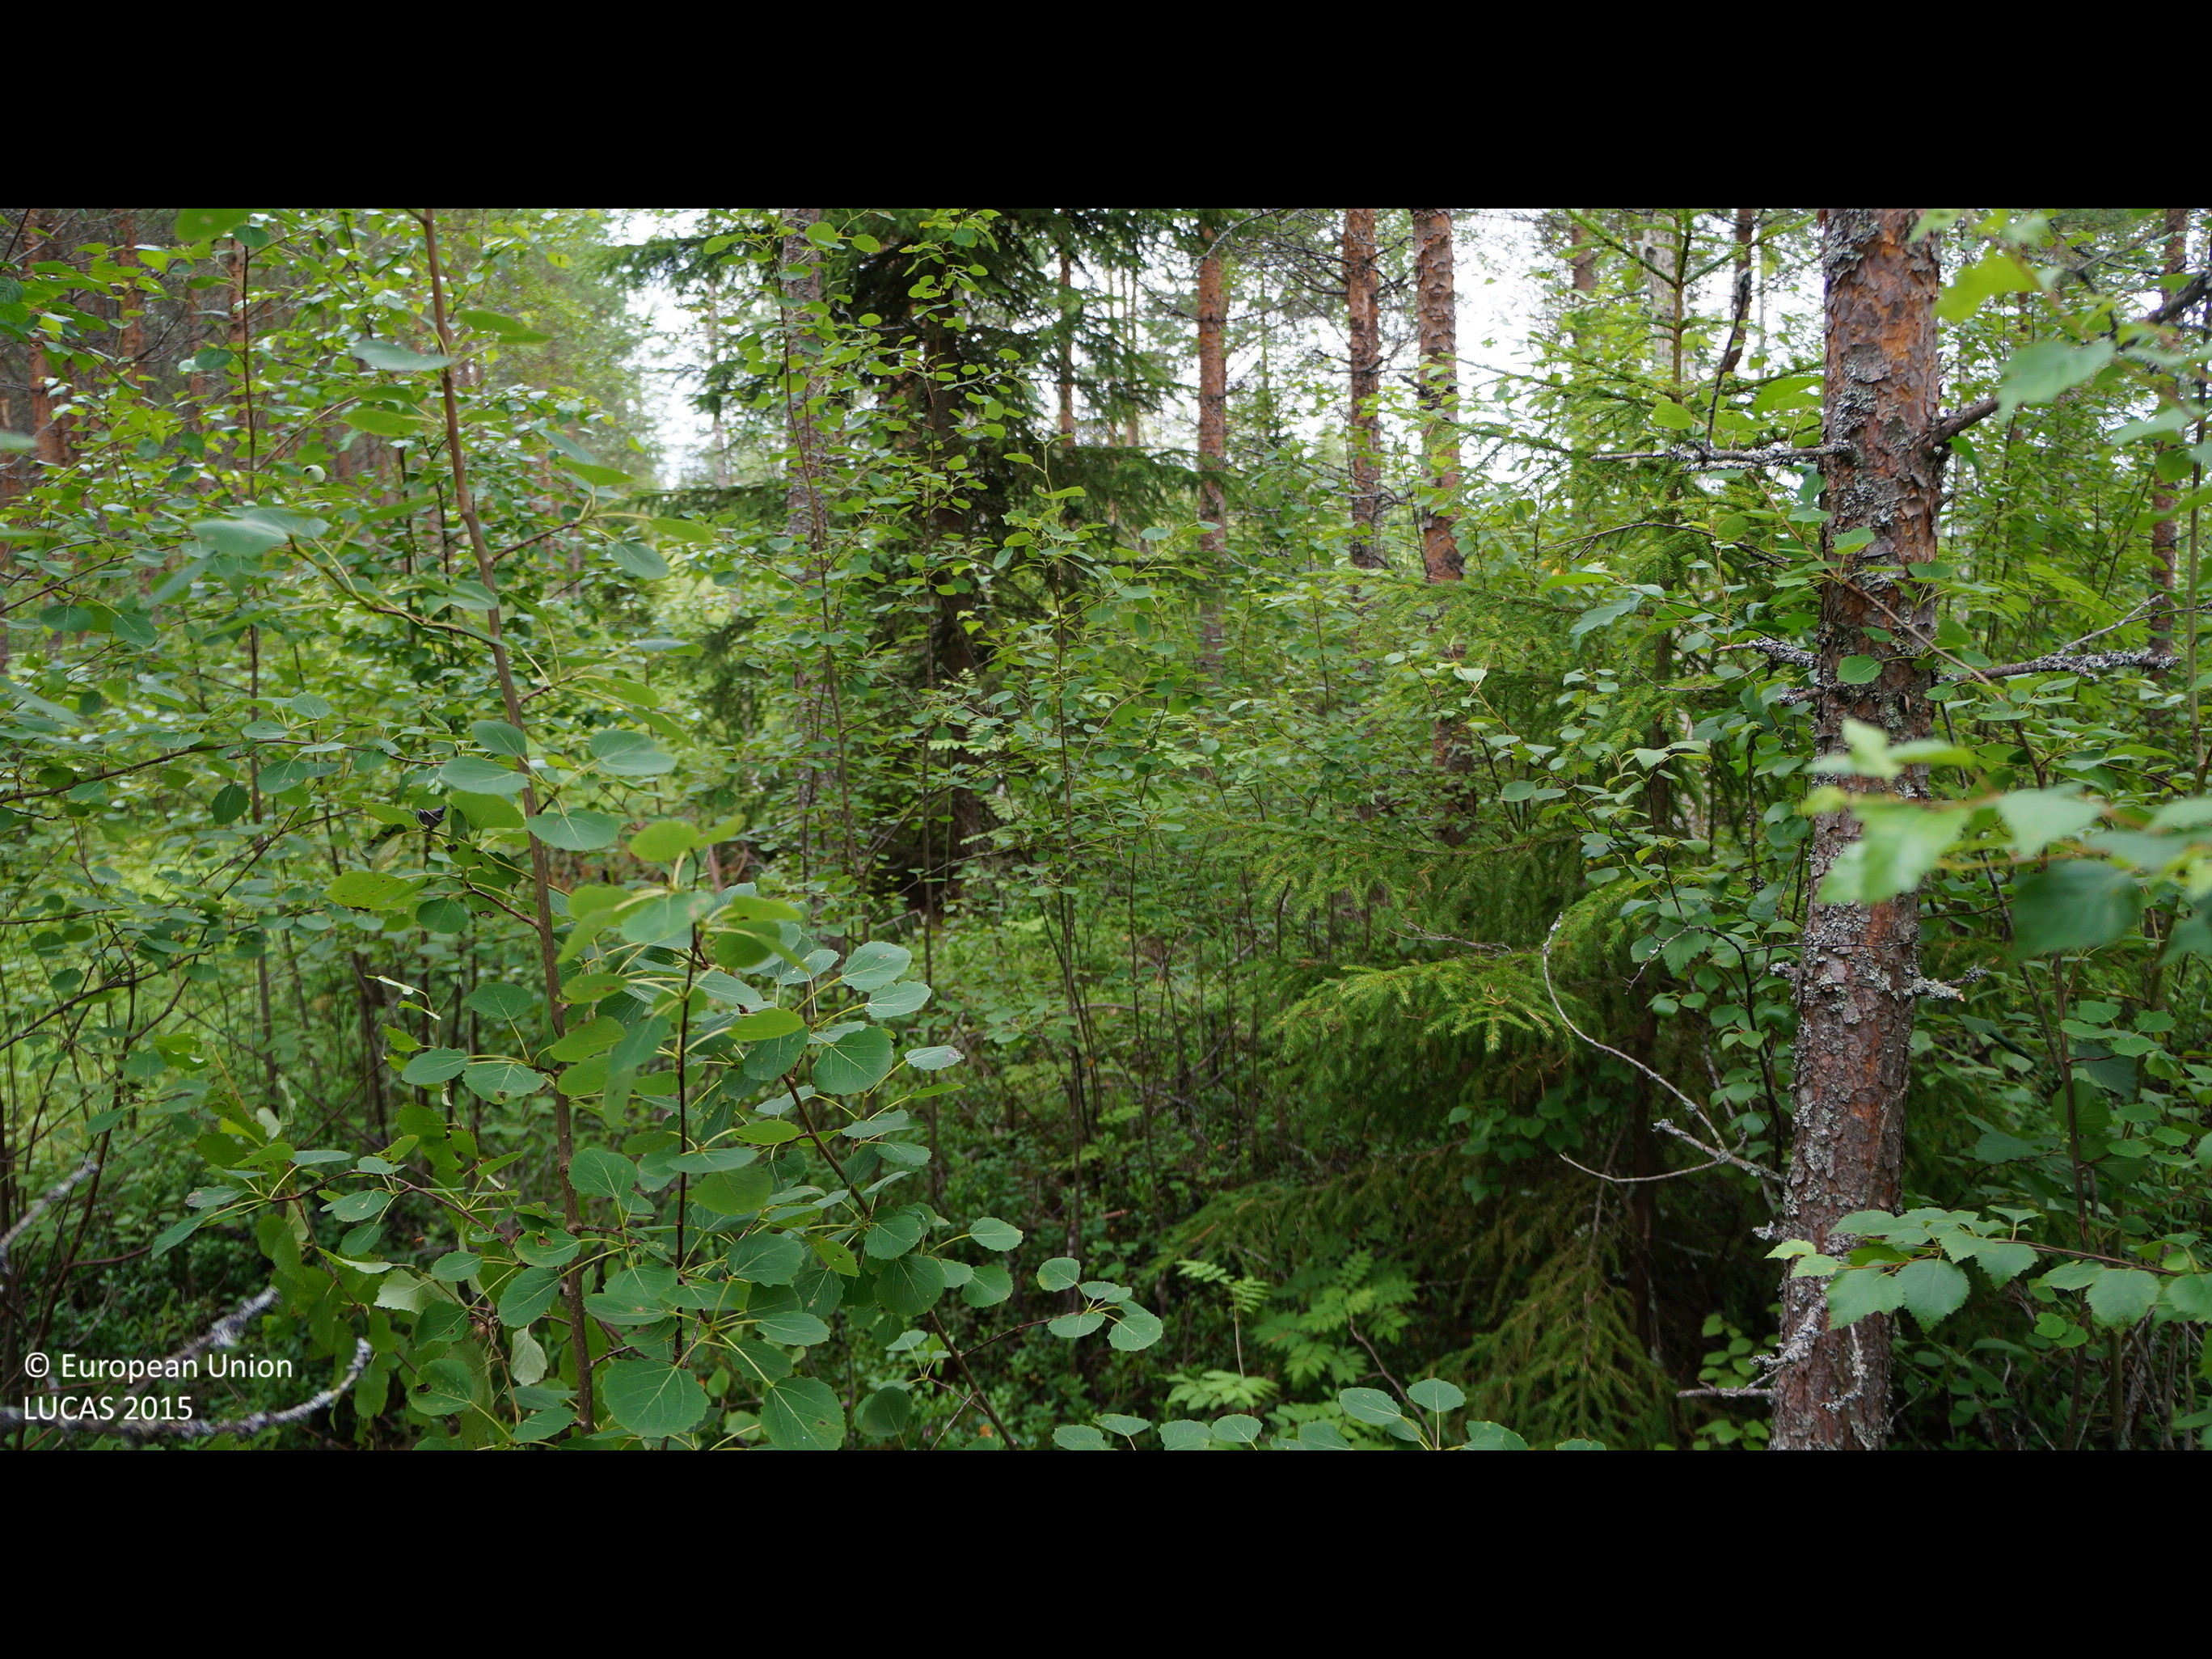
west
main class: Woodland
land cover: Pine dominated mixed woodland
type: boreal forest
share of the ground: 25 - 50 %
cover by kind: shrubs 55 %, coniferous forest trees 30 %, broadleaved forest trees 10 %, lichens and mosses 5 %
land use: Forestry
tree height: > 5 m
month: July
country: FI
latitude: 63.9620
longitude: 24.5525
